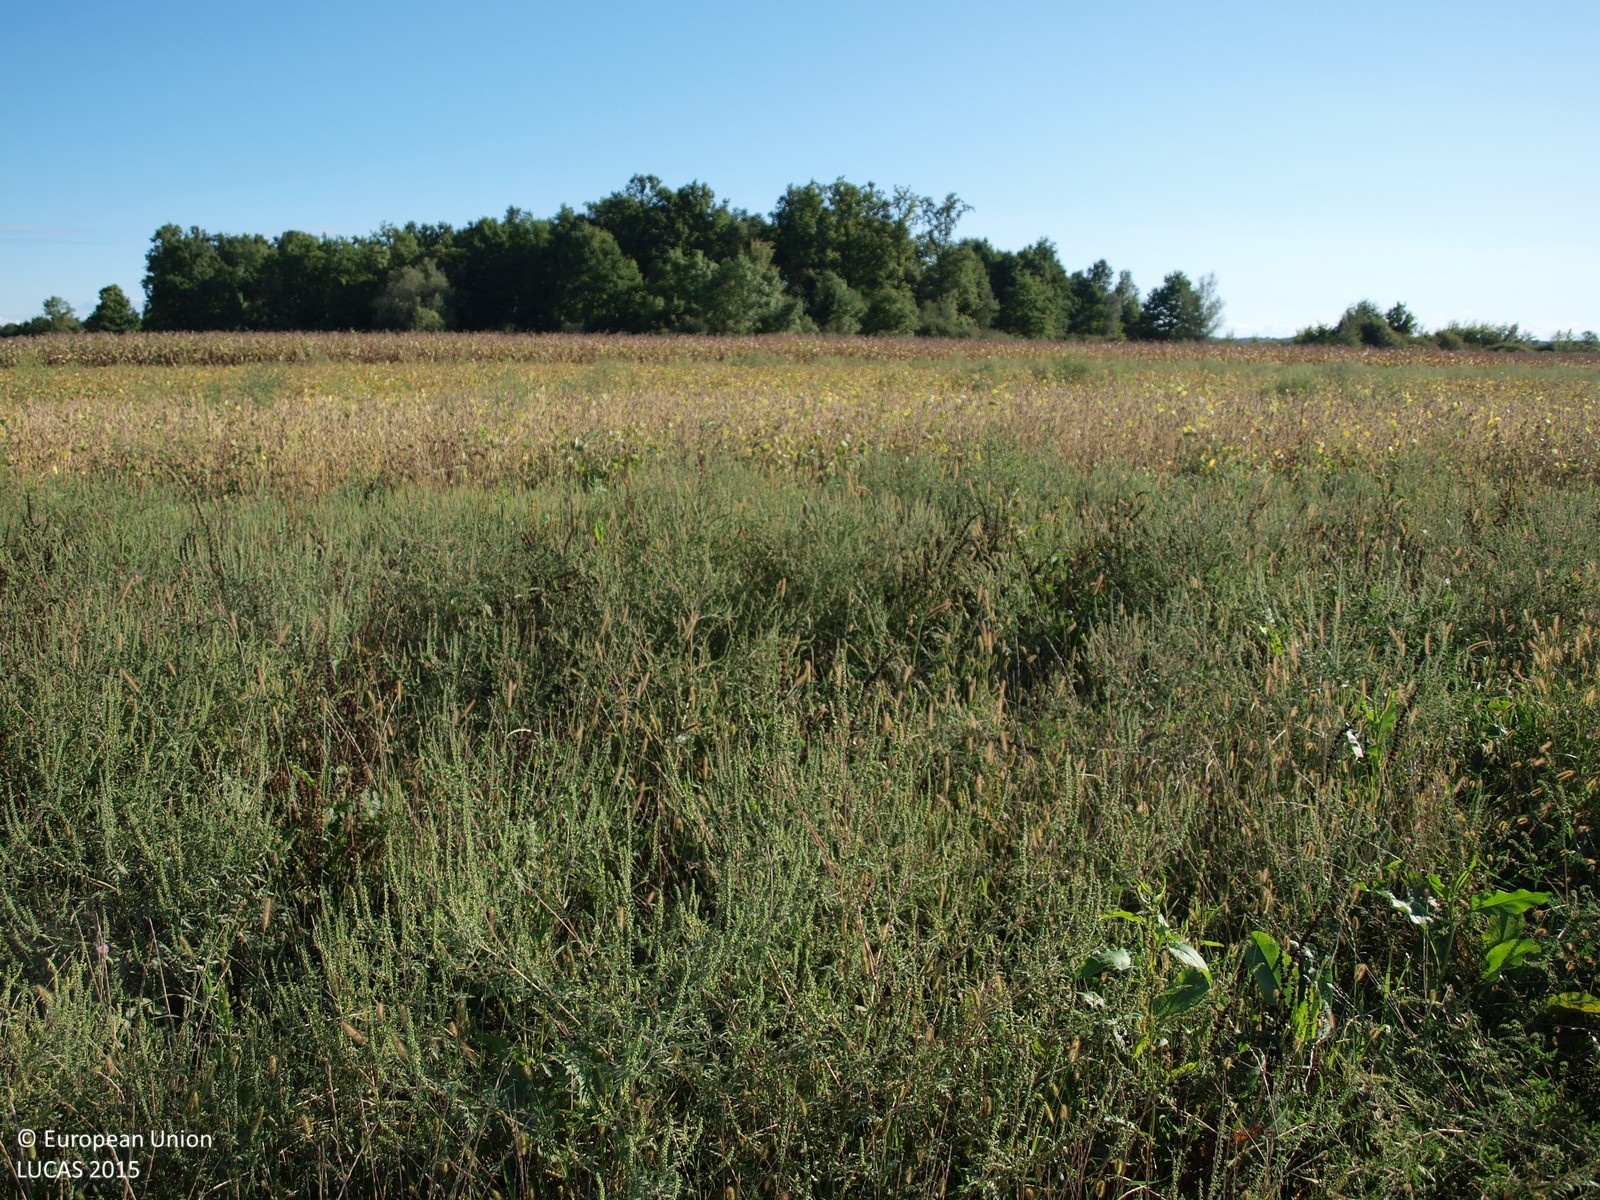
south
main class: Grassland
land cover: Spontaneously vegetated surfaces
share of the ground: > 75 %
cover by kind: herbaceous plants 100 %
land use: Fallow land
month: September
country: HR
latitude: 45.7134
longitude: 16.3059
